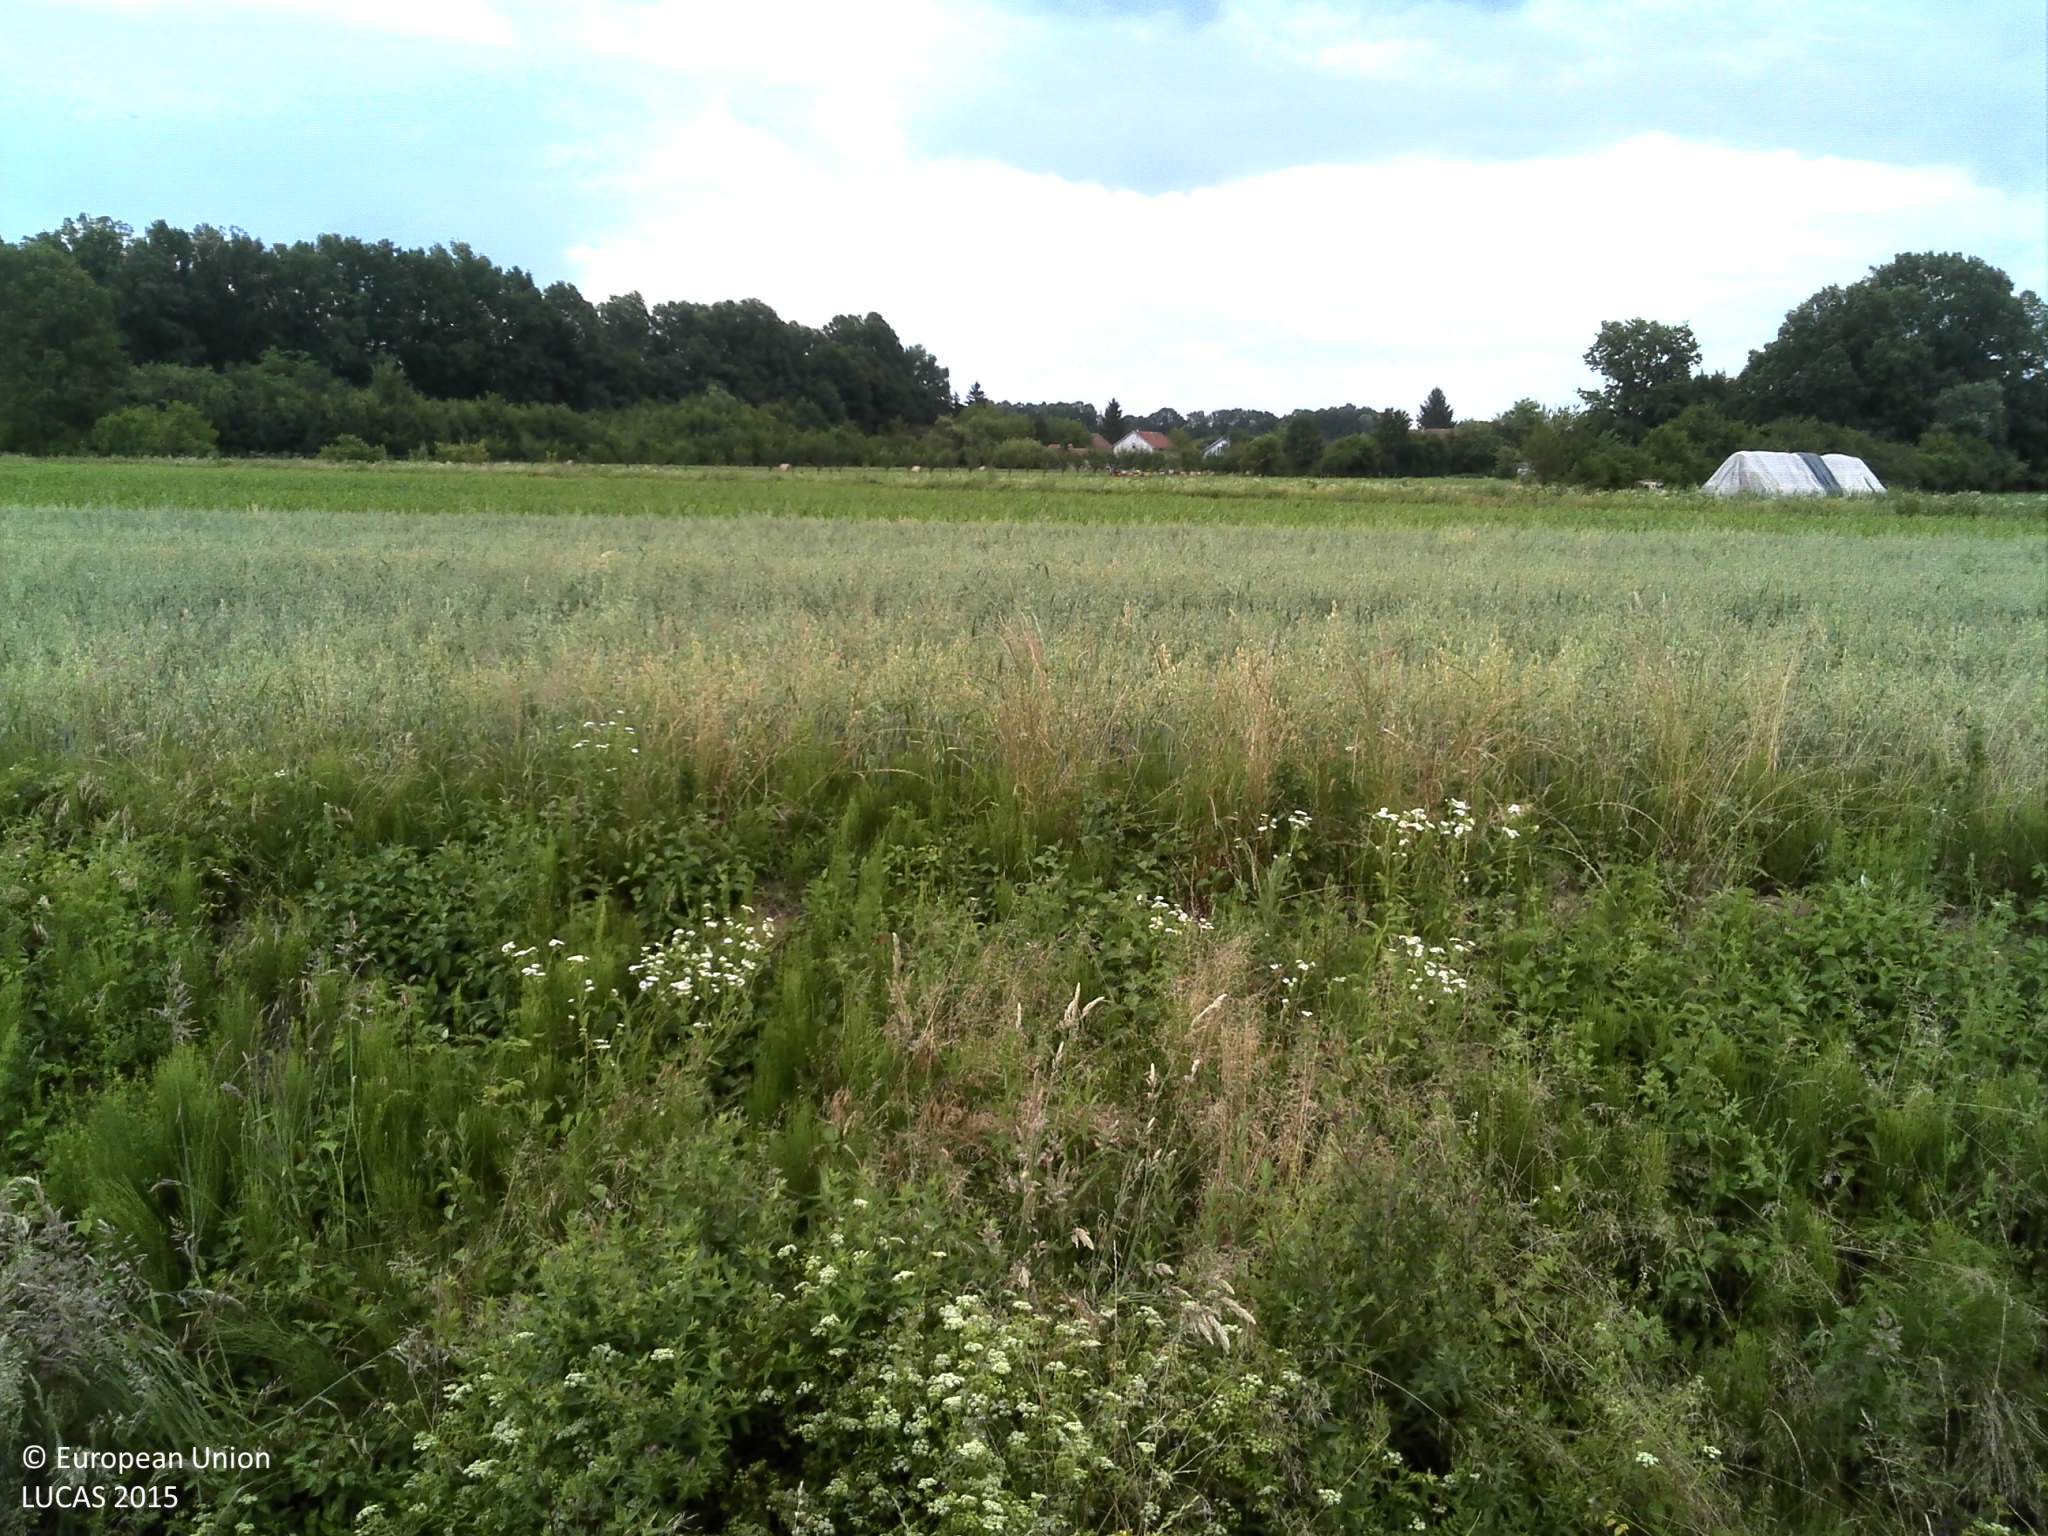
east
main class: Cropland
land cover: Rape and turnip rape
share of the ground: > 75 %
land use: Agriculture (excluding fallow land and kitchen gardens)
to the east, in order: Rape and turnip rape; Ditches and canals; Oats; Maize; Grass margins; Ditches and canals; Barley; Maize
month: June
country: HR
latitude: 45.2229
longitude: 17.4504
